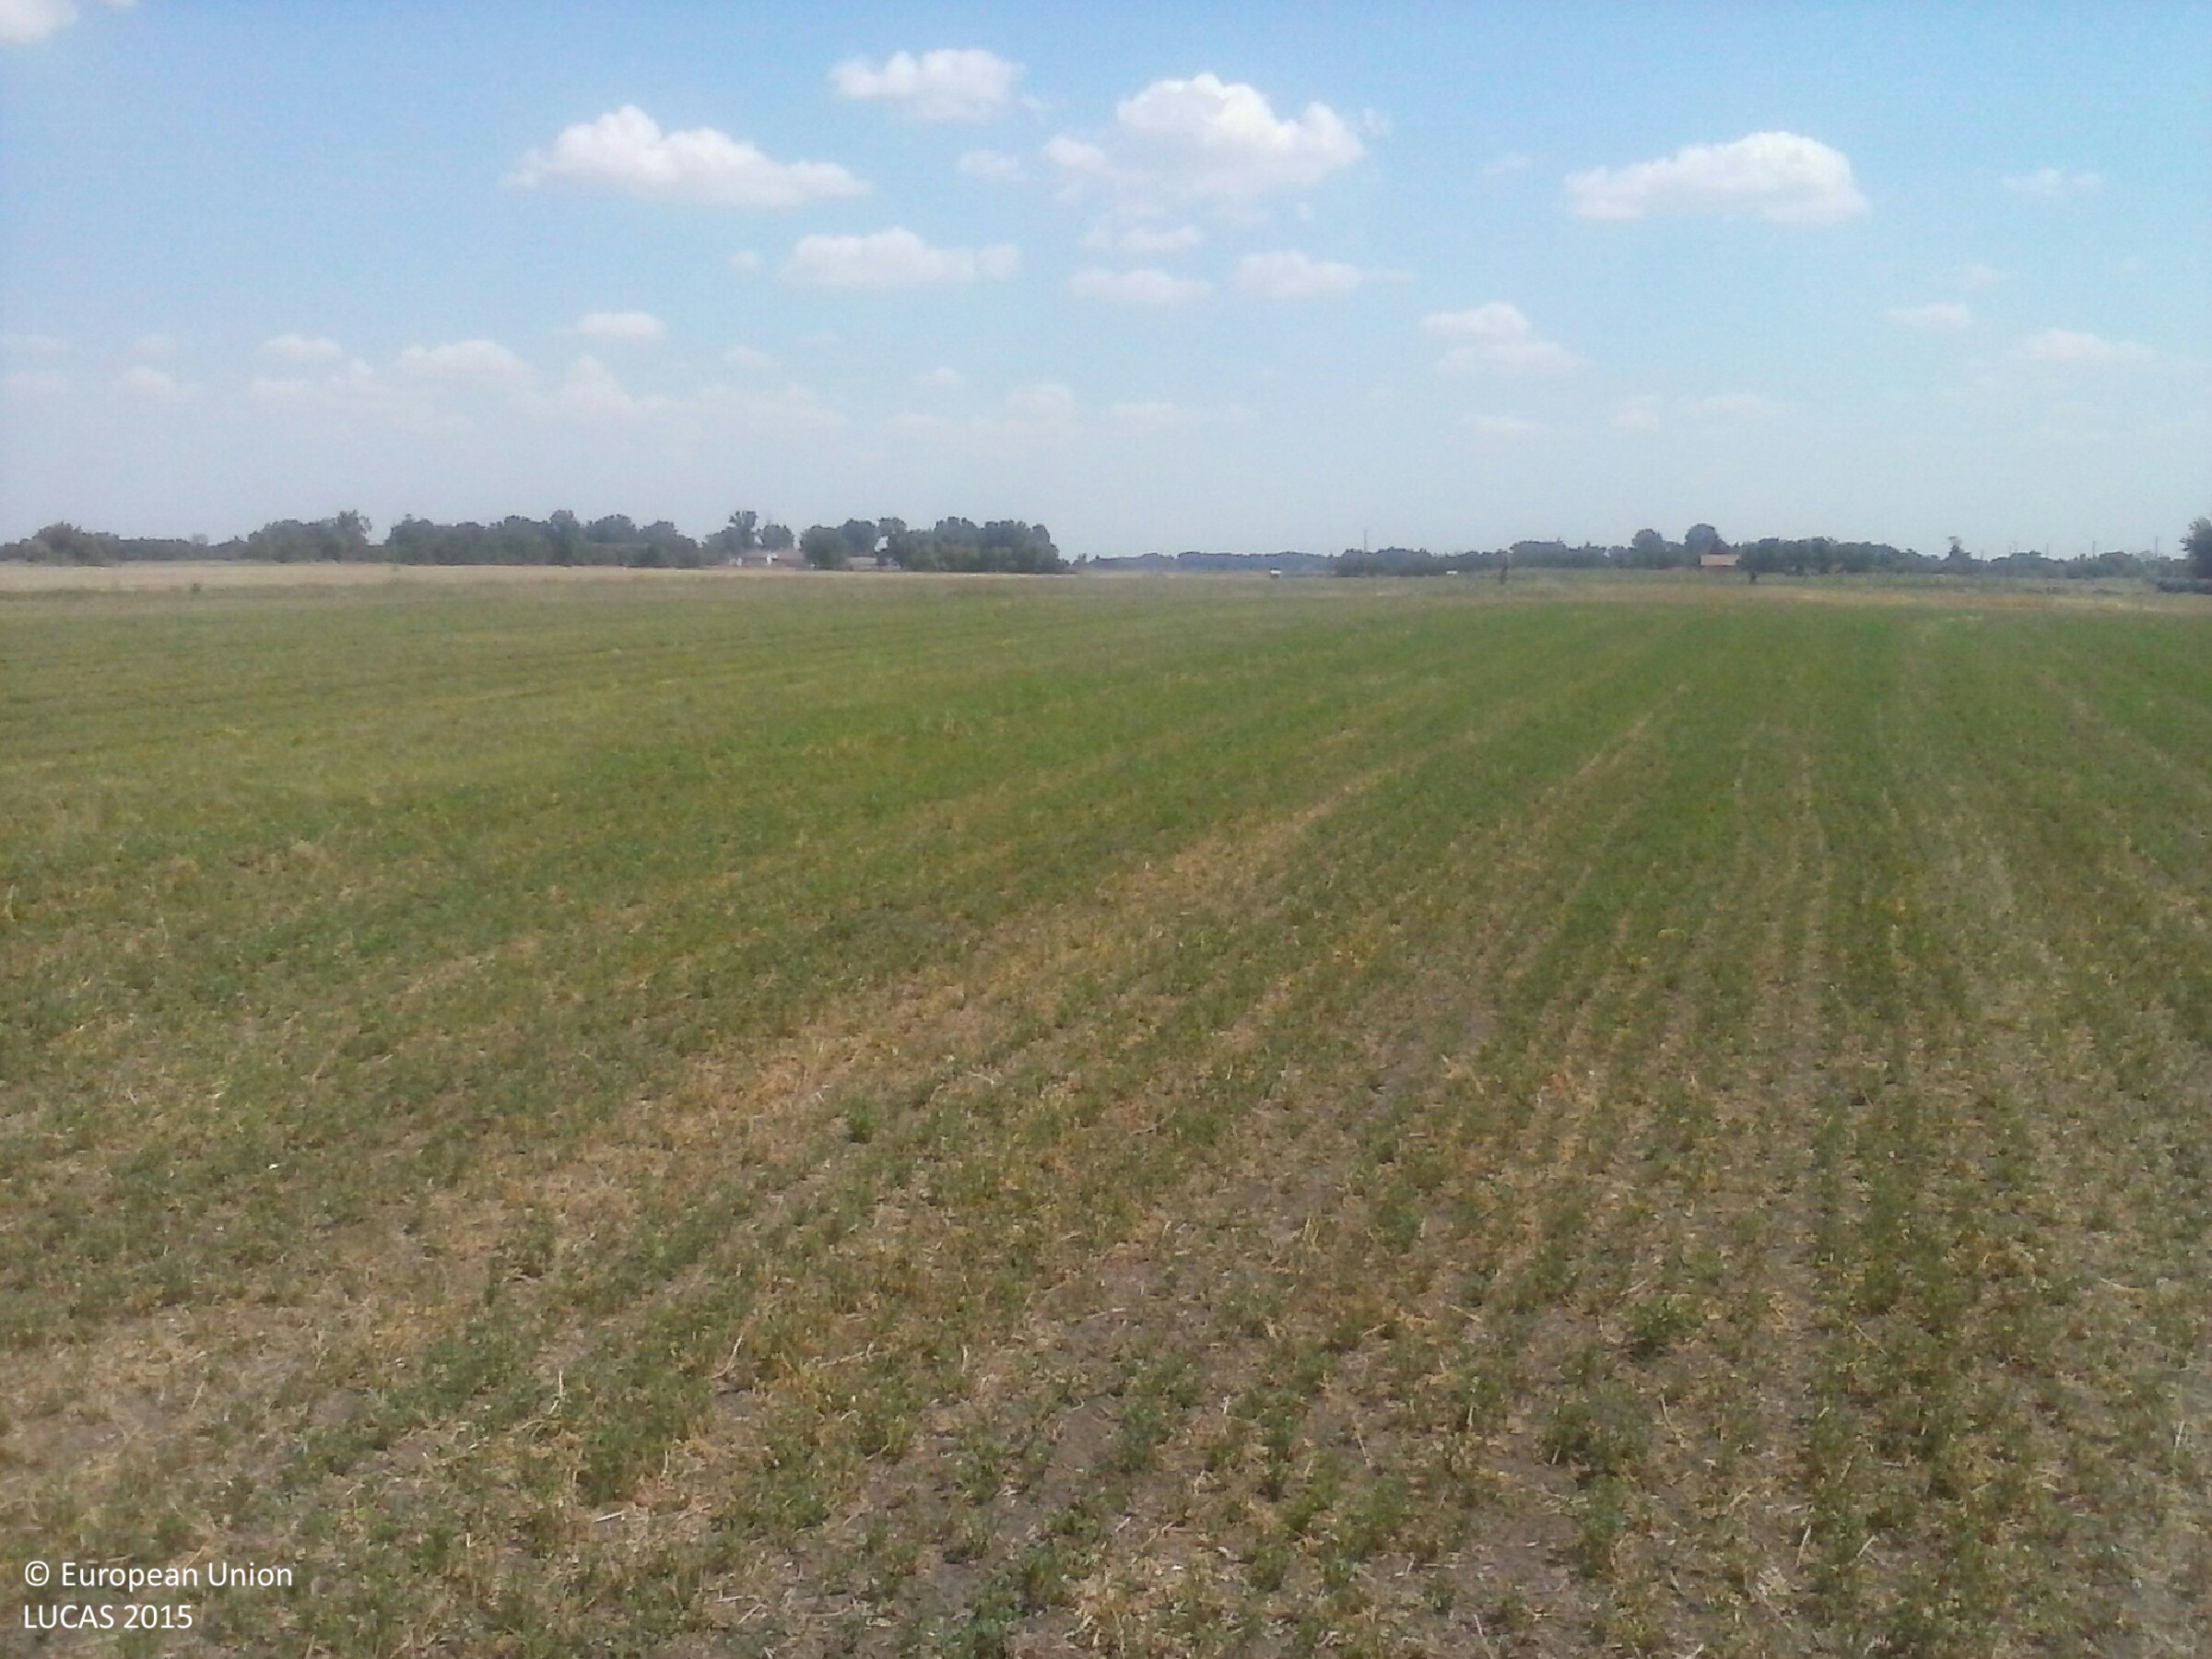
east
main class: Cropland
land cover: Lucerne
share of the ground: > 75 %
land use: Agriculture (excluding fallow land and kitchen gardens)
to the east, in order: Lucerne; Tracks; Grass margins; Common wheat
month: July
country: HU
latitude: 46.6880
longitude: 20.1046
